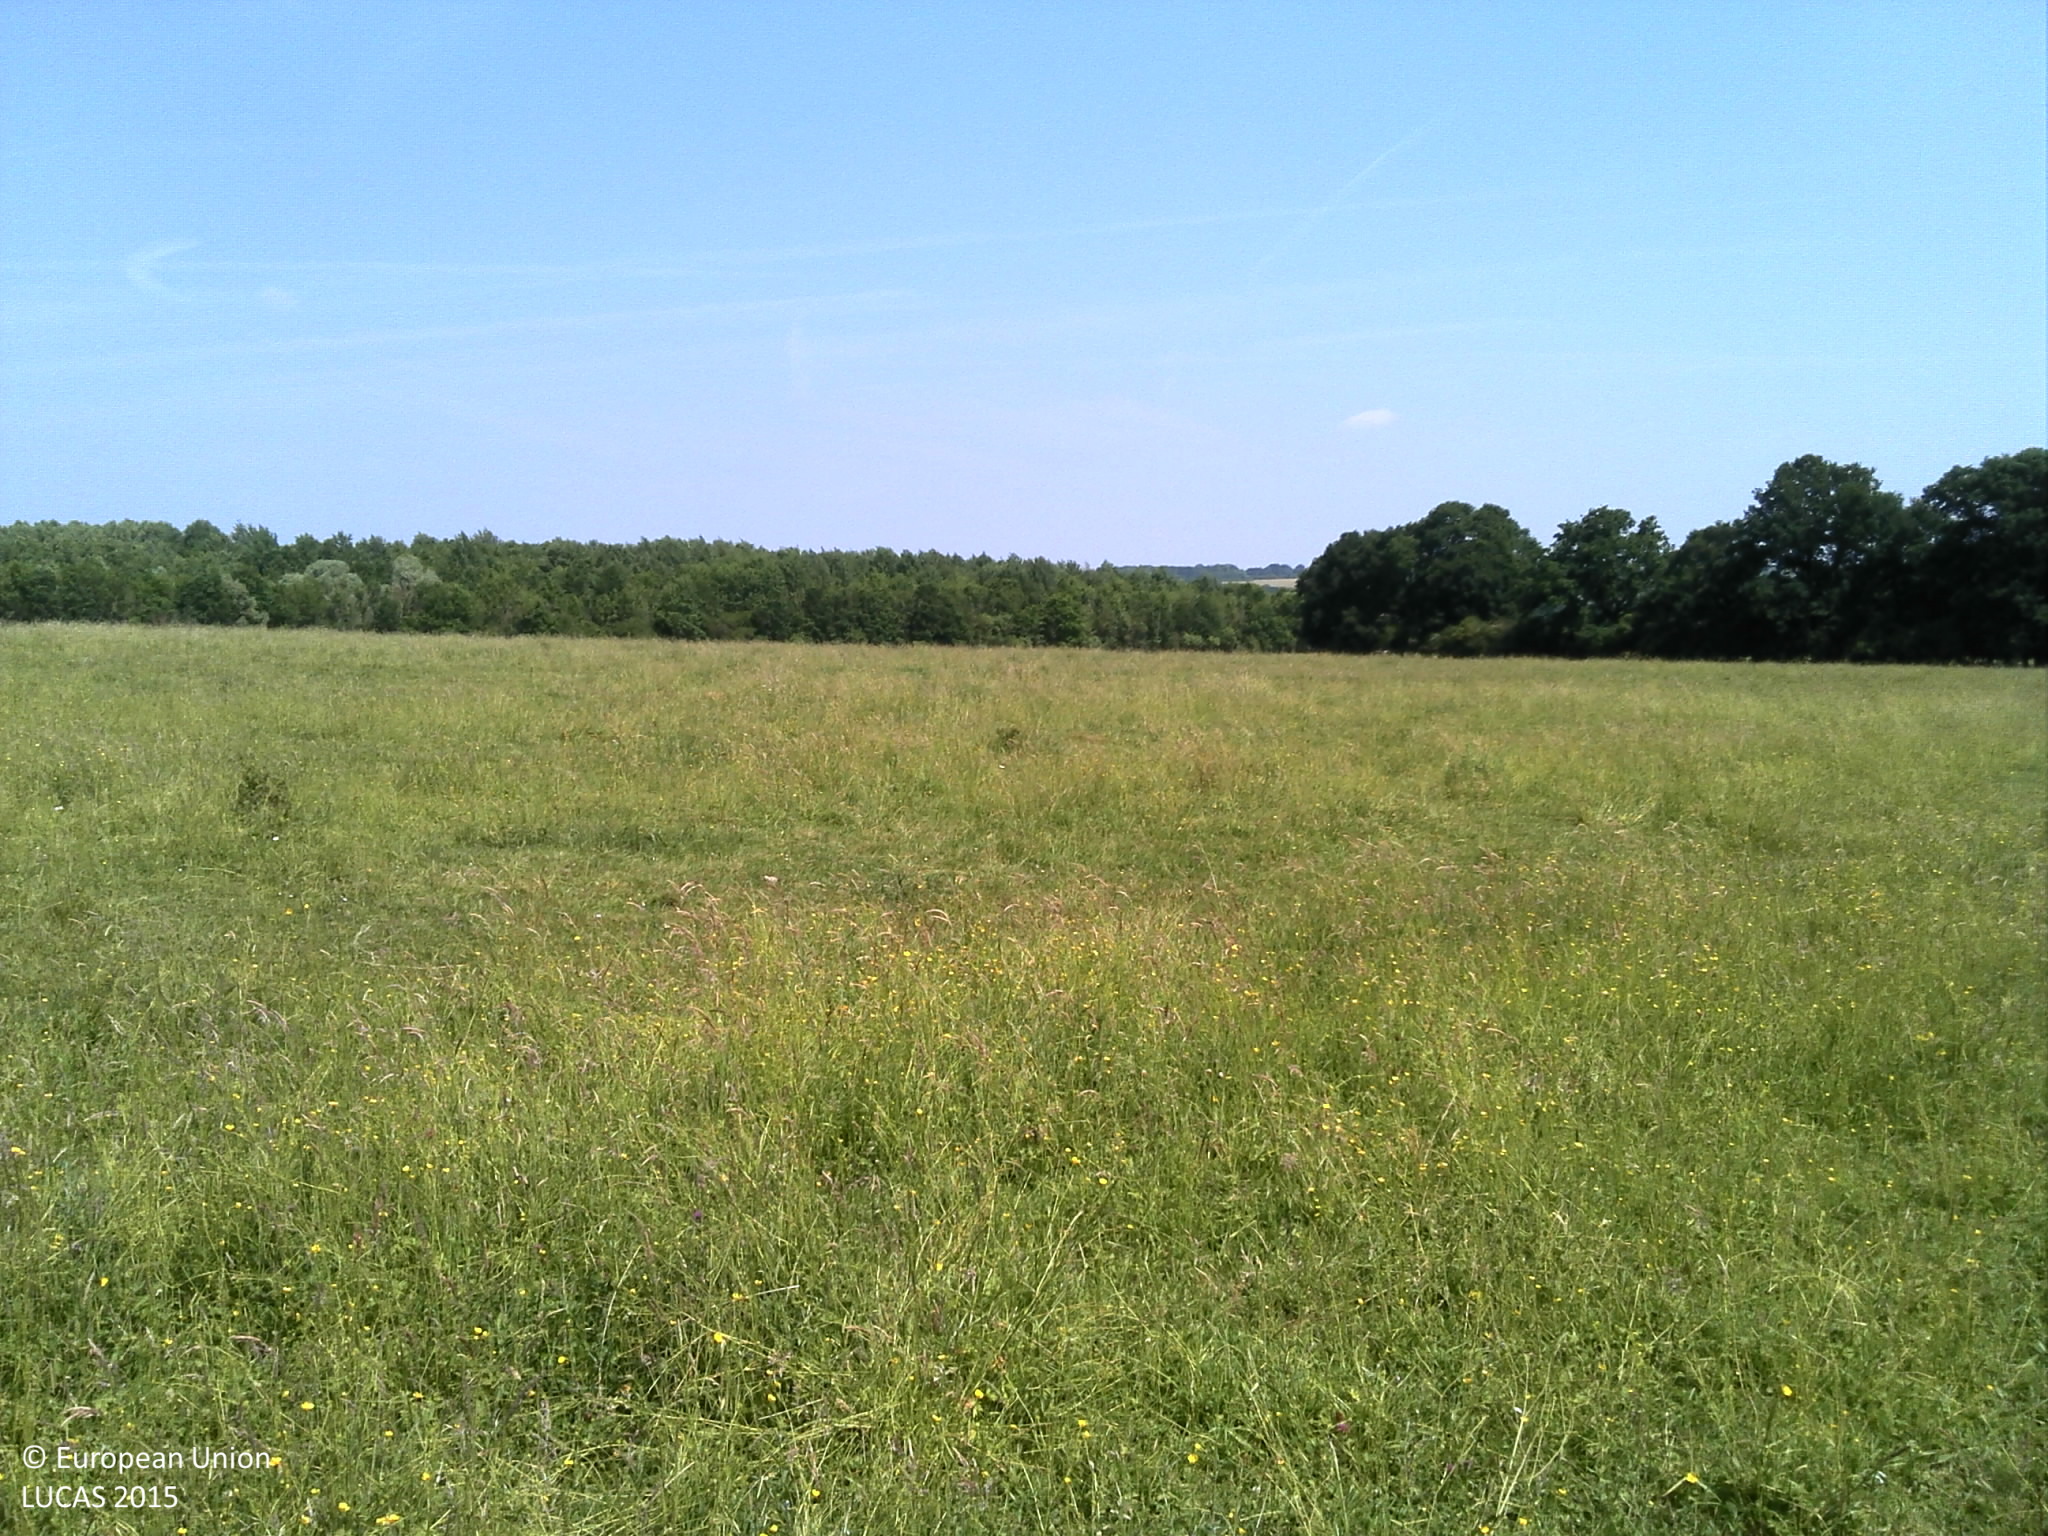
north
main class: Grassland
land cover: Grassland without tree/shrub cover
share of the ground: > 75 %
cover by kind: herbaceous plants 100 %
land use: Agriculture (excluding fallow land and kitchen gardens)
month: June
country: FR
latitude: 49.0590
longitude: 6.2090
